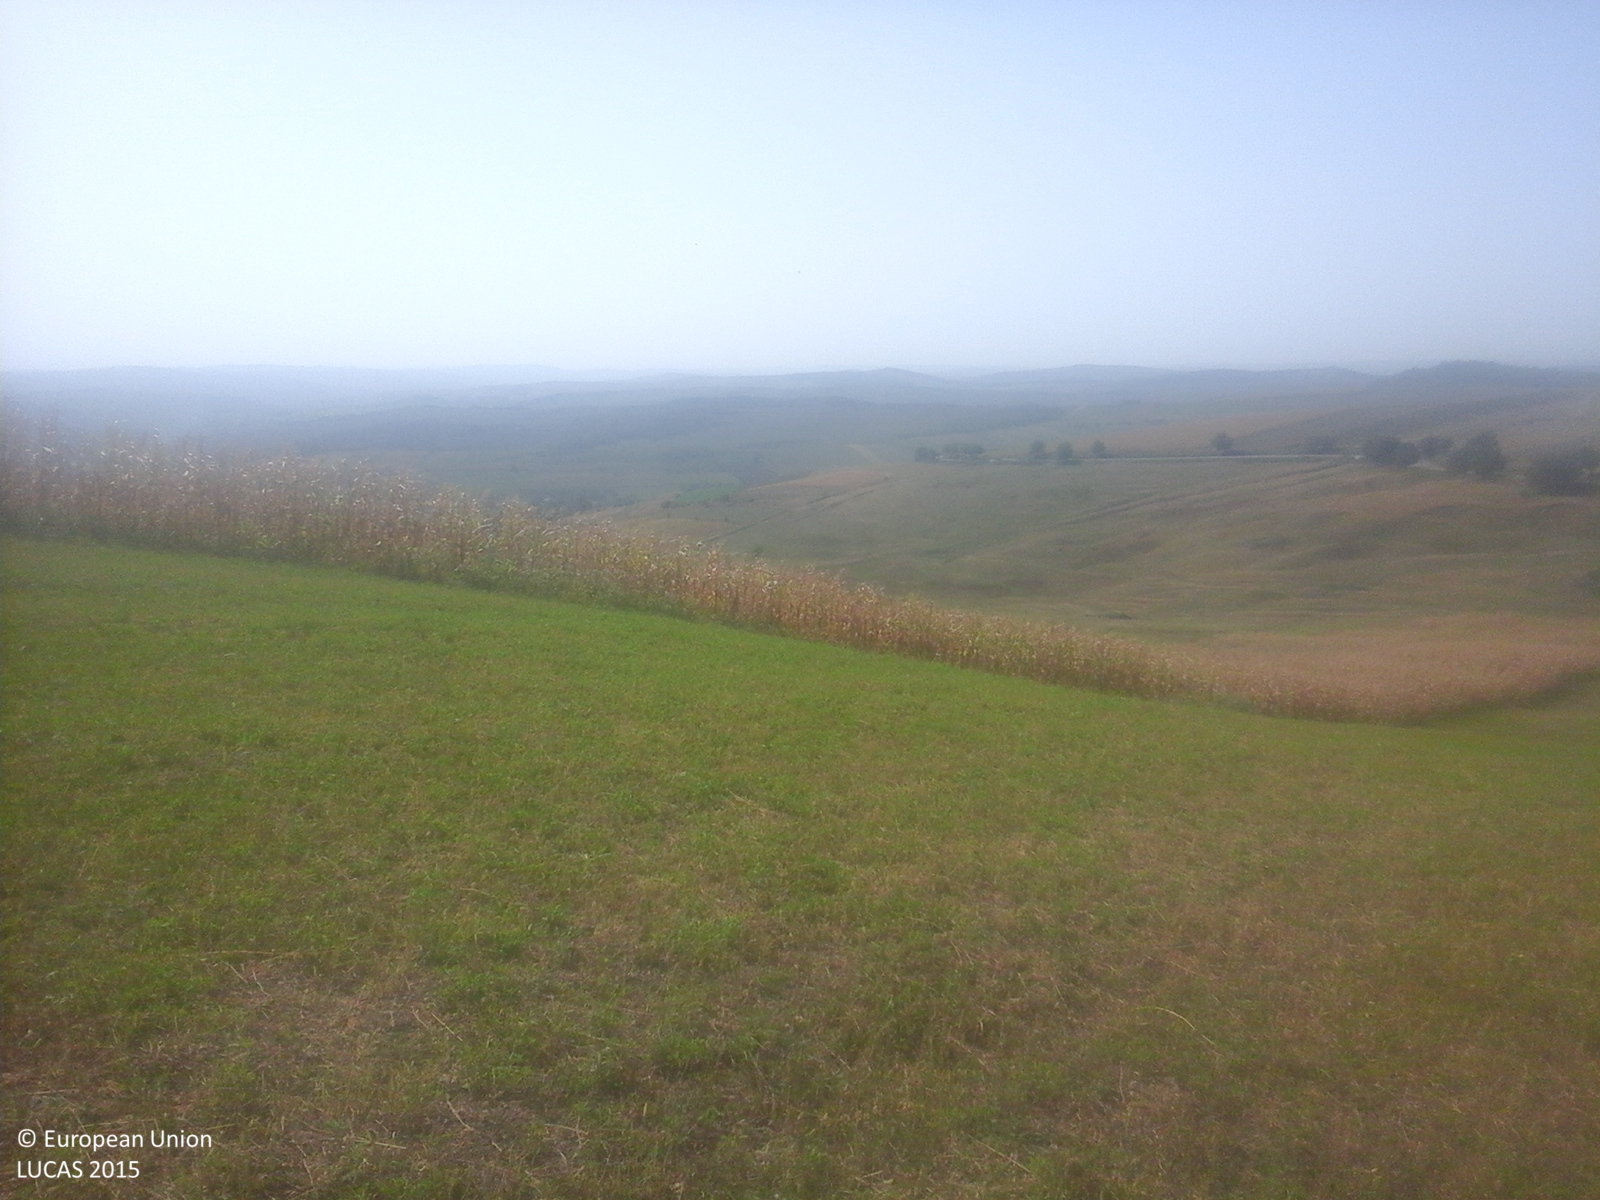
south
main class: Cropland
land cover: Lucerne
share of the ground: > 75 %
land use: Agriculture (excluding fallow land and kitchen gardens)
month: September
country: RO
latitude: 46.8904
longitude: 24.2455
